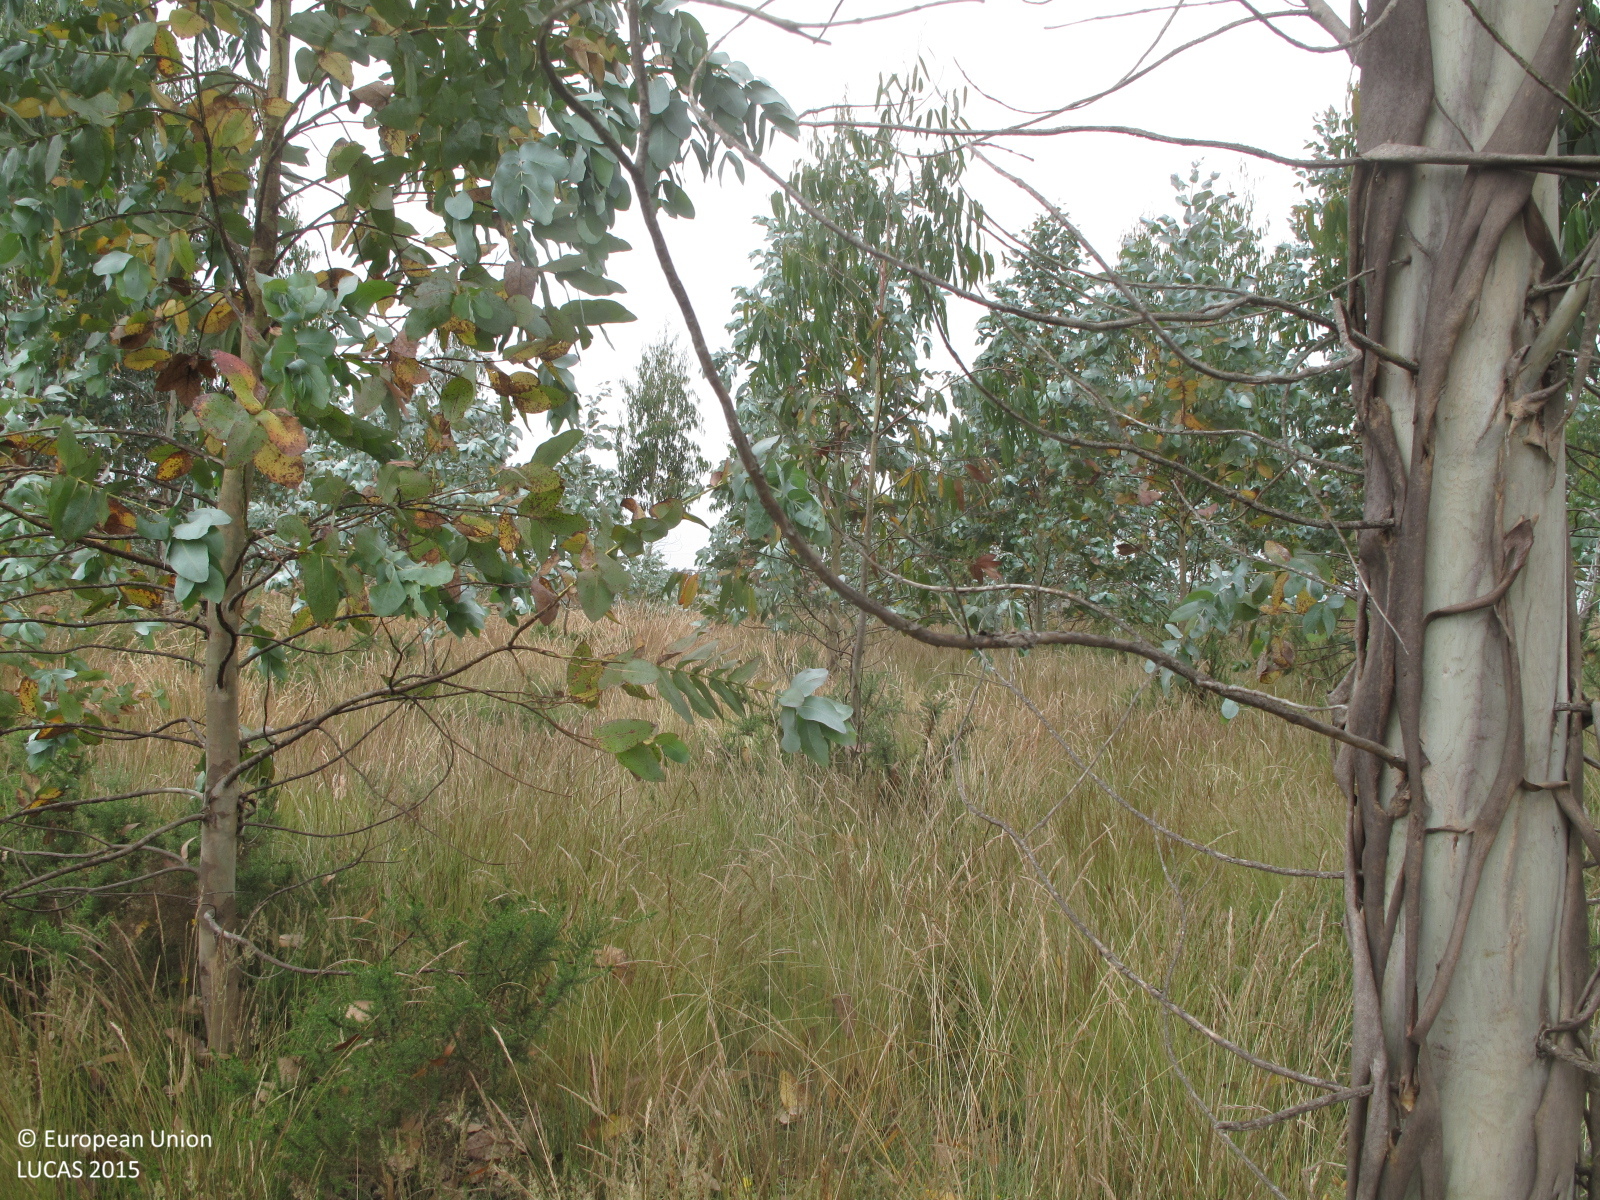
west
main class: Woodland
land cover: Broadleaved woodland
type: exotic forest
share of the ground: 25 - 50 %
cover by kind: herbaceous plants 50 %, broadleaved forest trees 40 %, shrubs 10 %
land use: Forestry
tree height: < 5 m
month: June
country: ES
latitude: 43.1597
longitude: -8.0367
